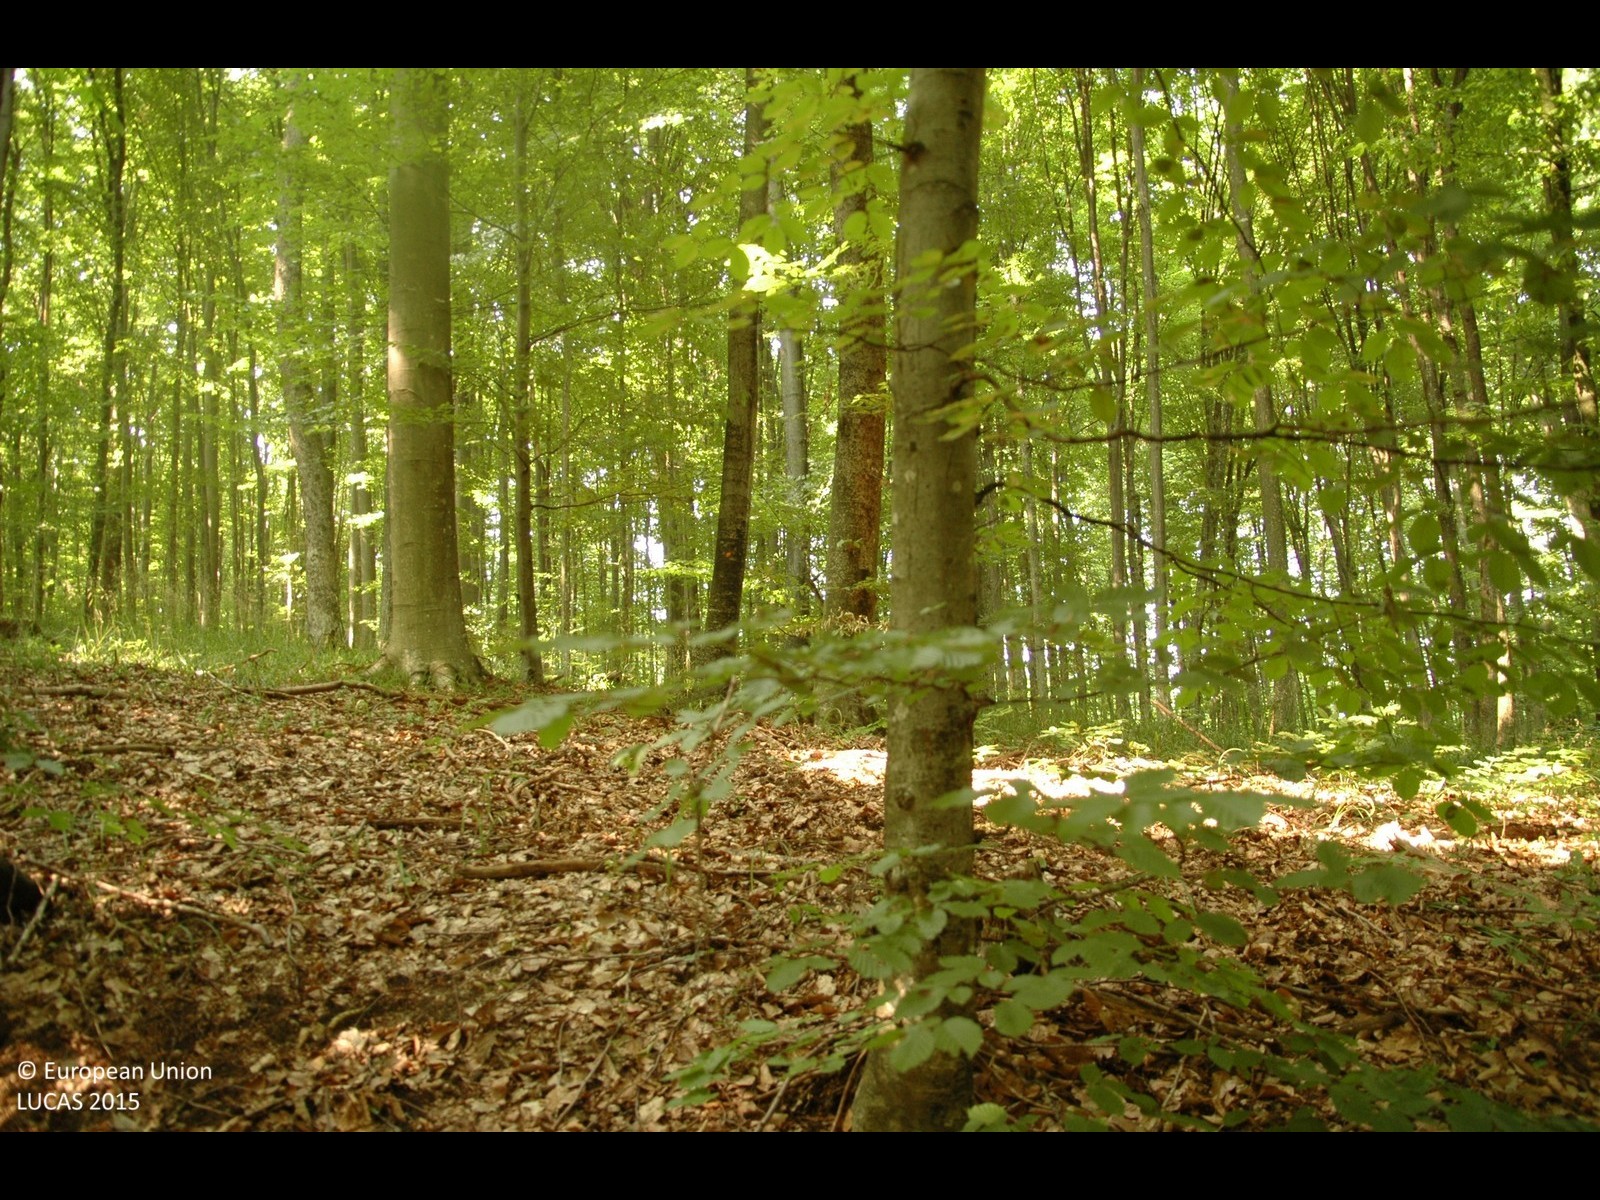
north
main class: Woodland
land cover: Broadleaved woodland
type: beech forest
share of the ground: > 75 %
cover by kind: broadleaved forest trees 100 %
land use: Forestry
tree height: > 5 m
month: July
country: HR
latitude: 46.1511
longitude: 16.5389
